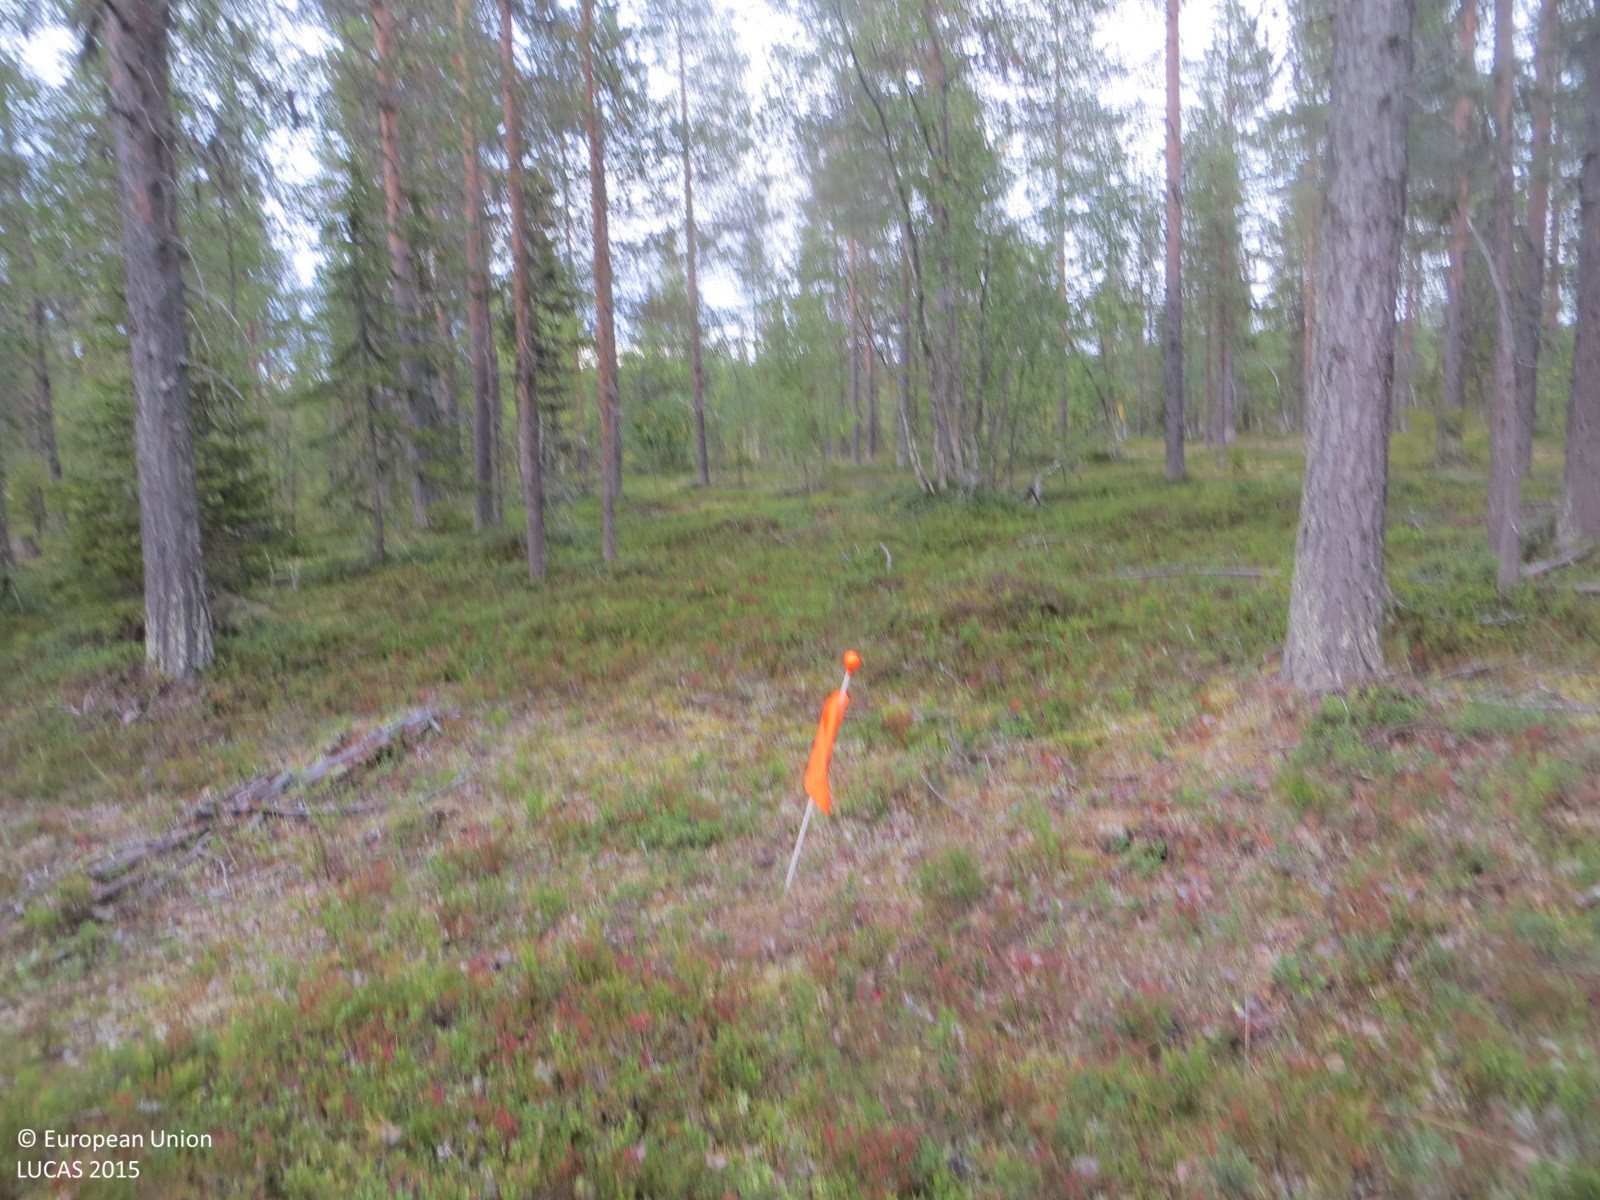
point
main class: Woodland
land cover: Pine dominated coniferous woodland
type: boreal forest
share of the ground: 50 - 75 %
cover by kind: coniferous forest trees 50 %, shrubs 50 %
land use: Forestry
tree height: > 5 m
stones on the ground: < 10 %
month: August
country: FI
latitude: 68.0294
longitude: 24.7571
